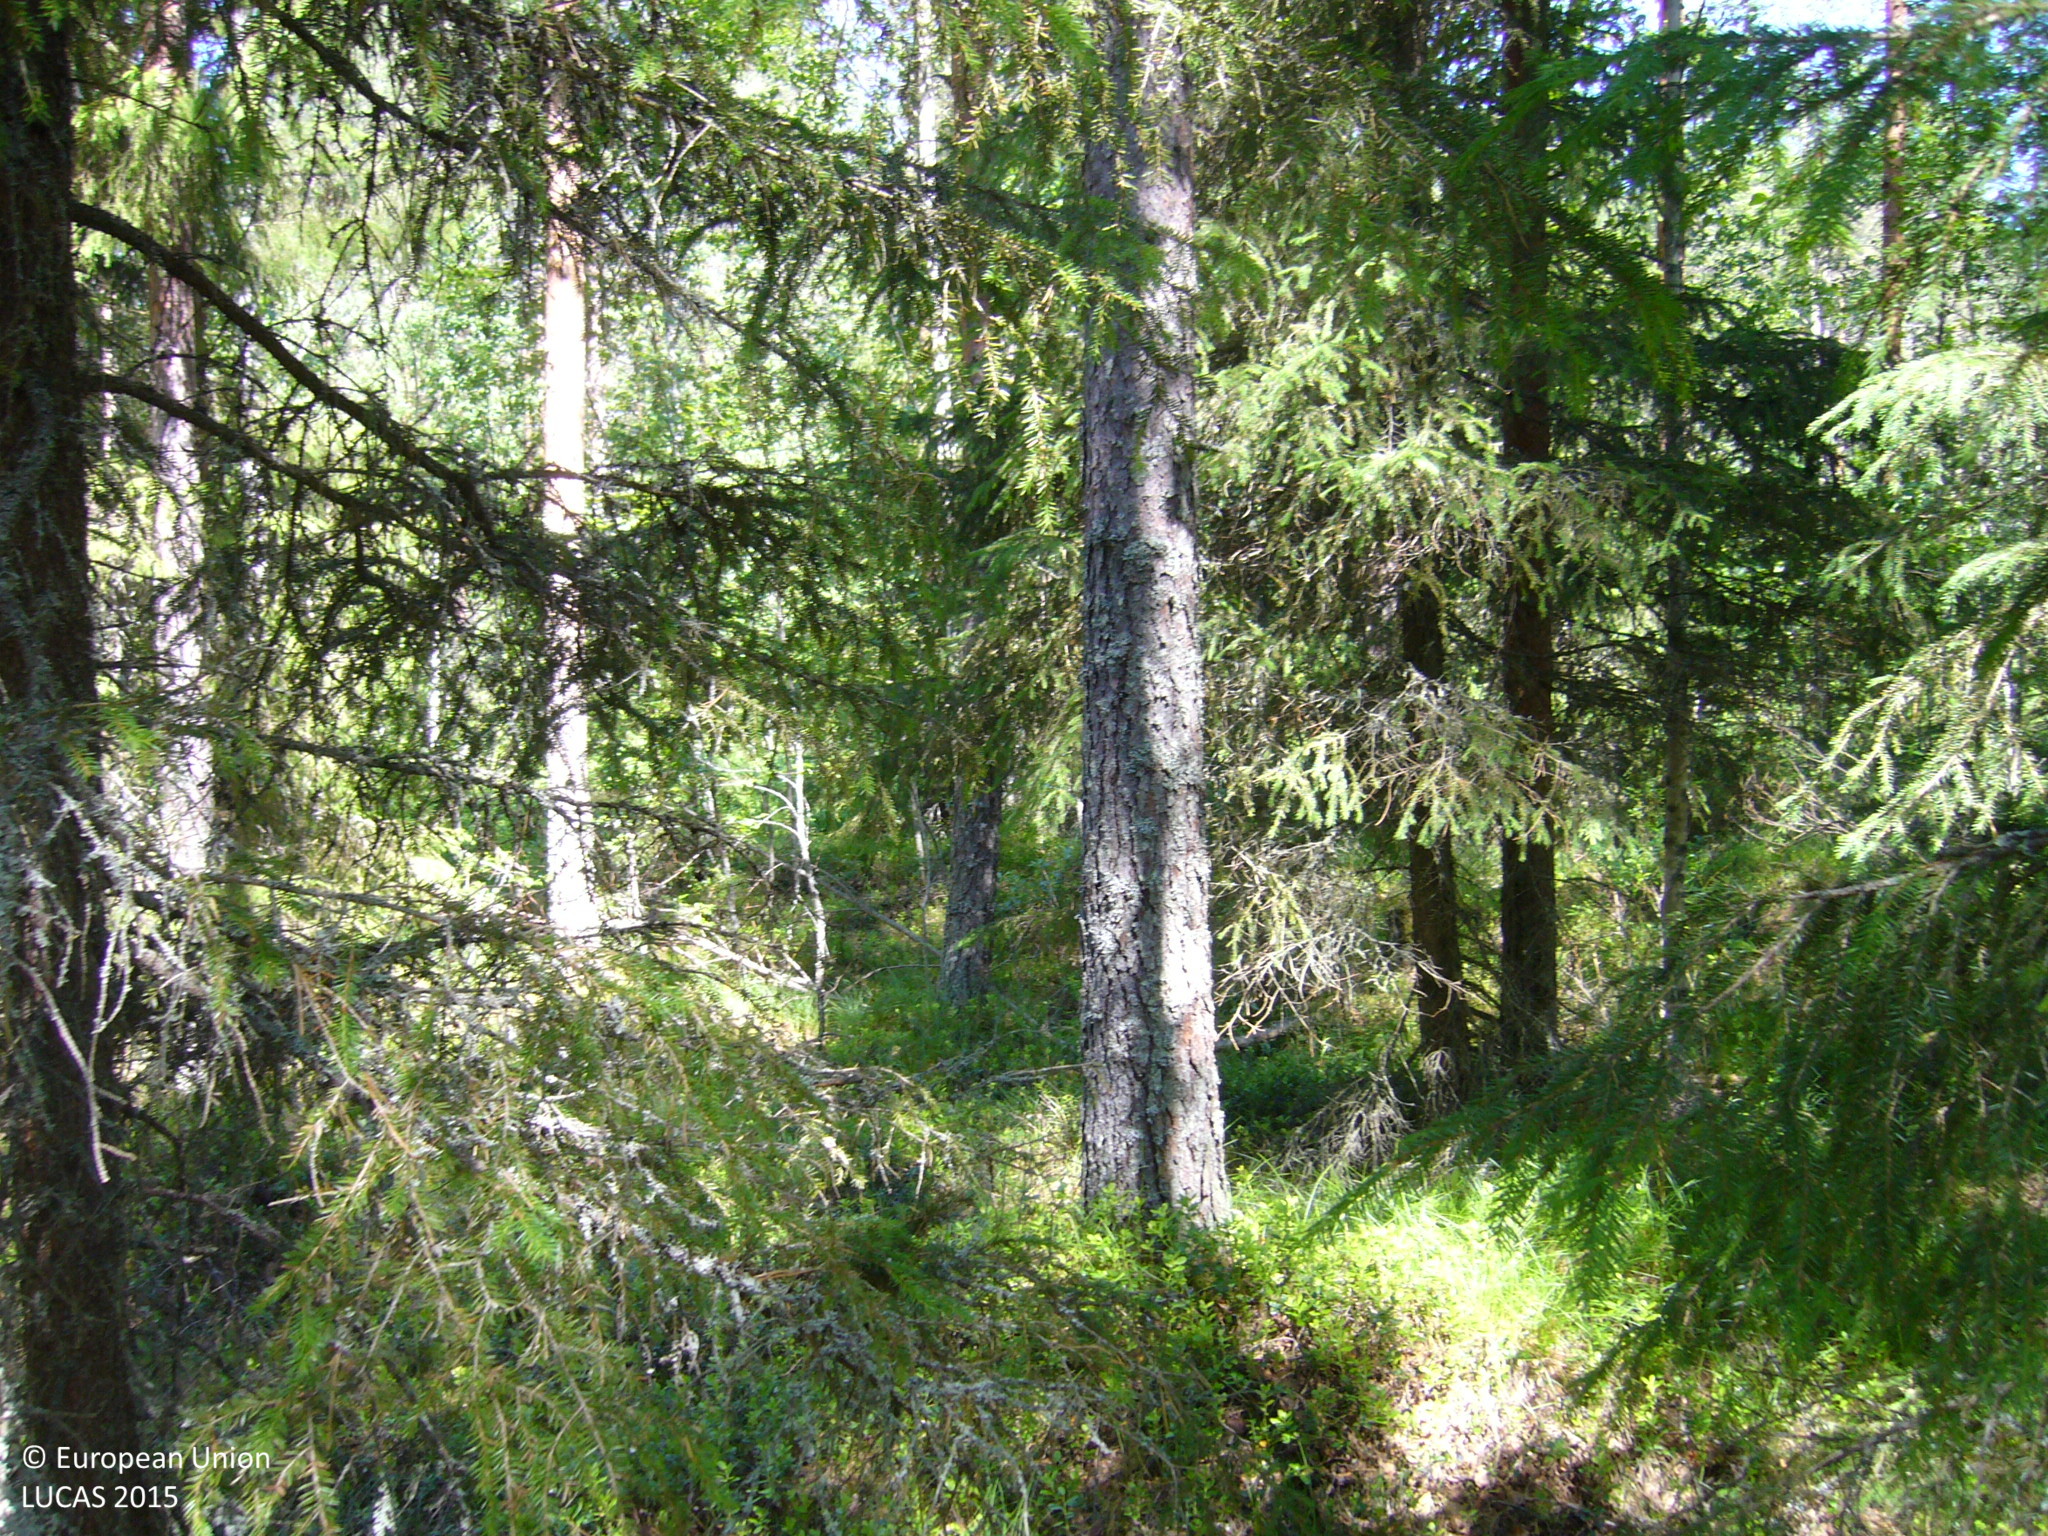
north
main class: Woodland
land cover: Pine dominated coniferous woodland
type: boreal forest
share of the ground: > 75 %
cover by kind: coniferous forest trees 60 %, shrubs 25 %, broadleaved forest trees 15 %
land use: Forestry
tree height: > 5 m
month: July
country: FI
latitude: 63.3895
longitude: 25.8596
